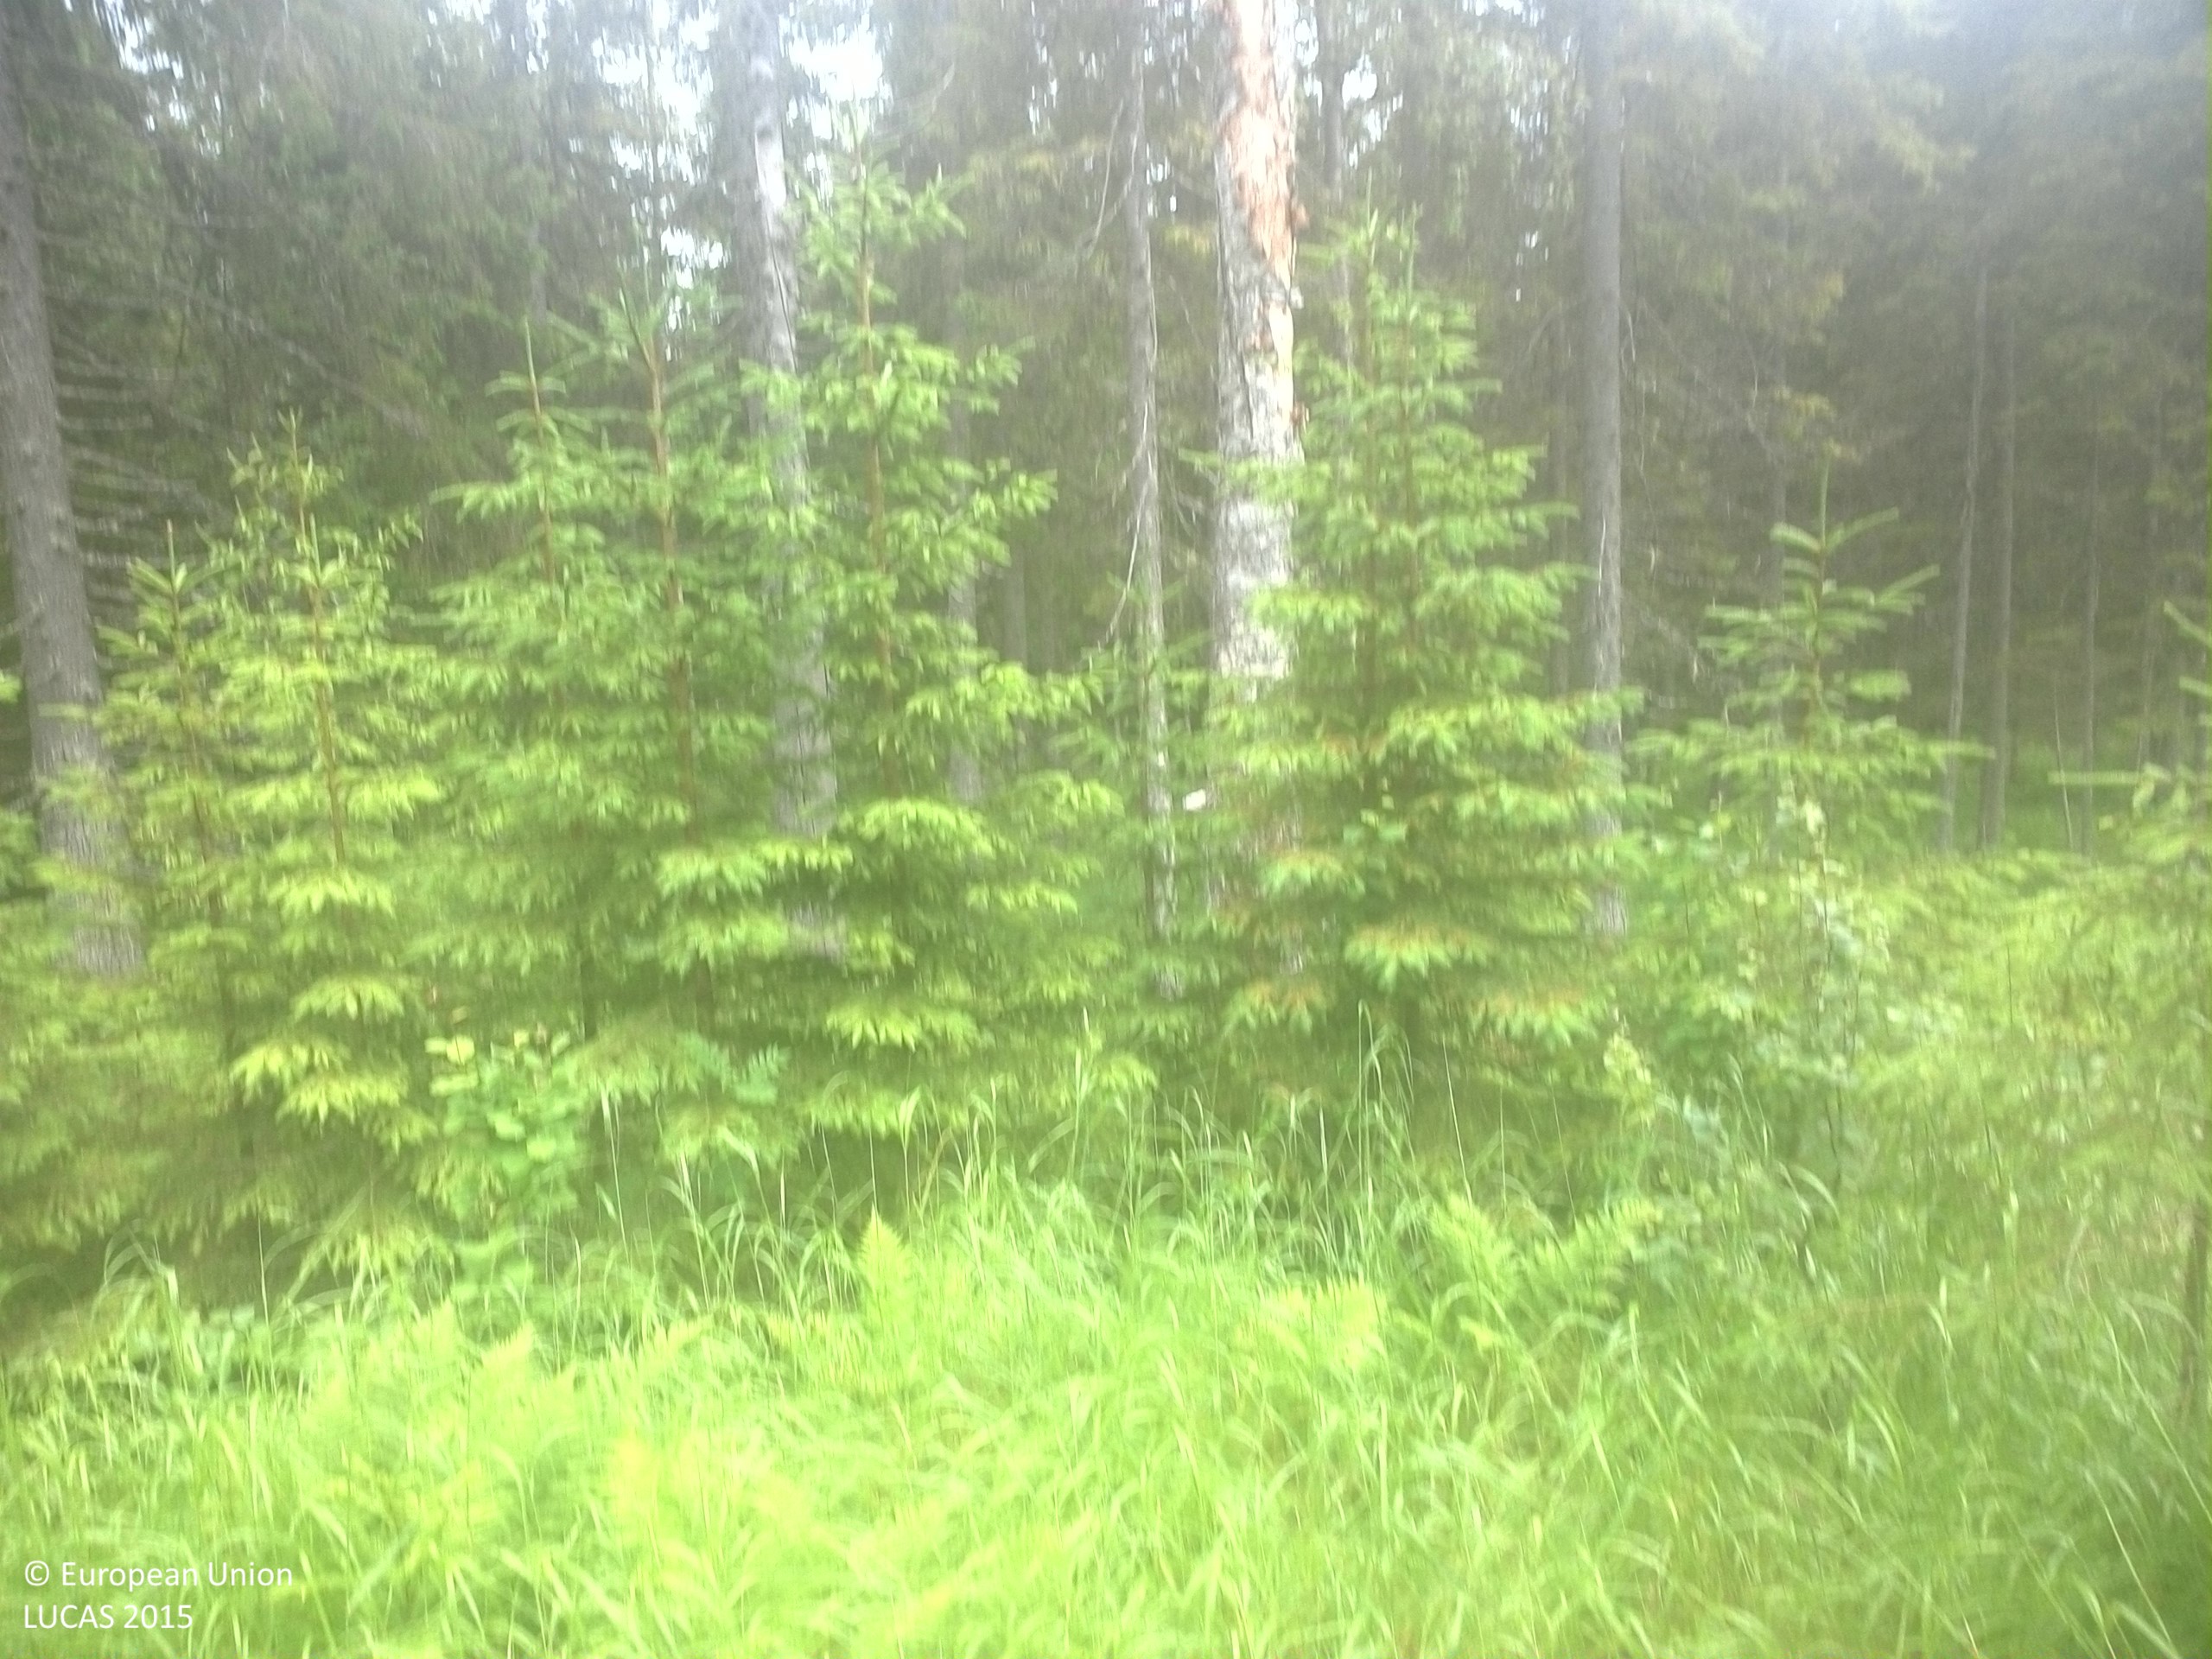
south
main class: Woodland
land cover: Spruce dominated coniferous woodland
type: boreal forest
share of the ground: 50 - 75 %
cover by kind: coniferous forest trees 60 %, herbaceous plants 30 %, broadleaved forest trees 10 %
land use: Forestry
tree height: < 5 m
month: July
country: SE
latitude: 63.5886
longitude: 18.4989
